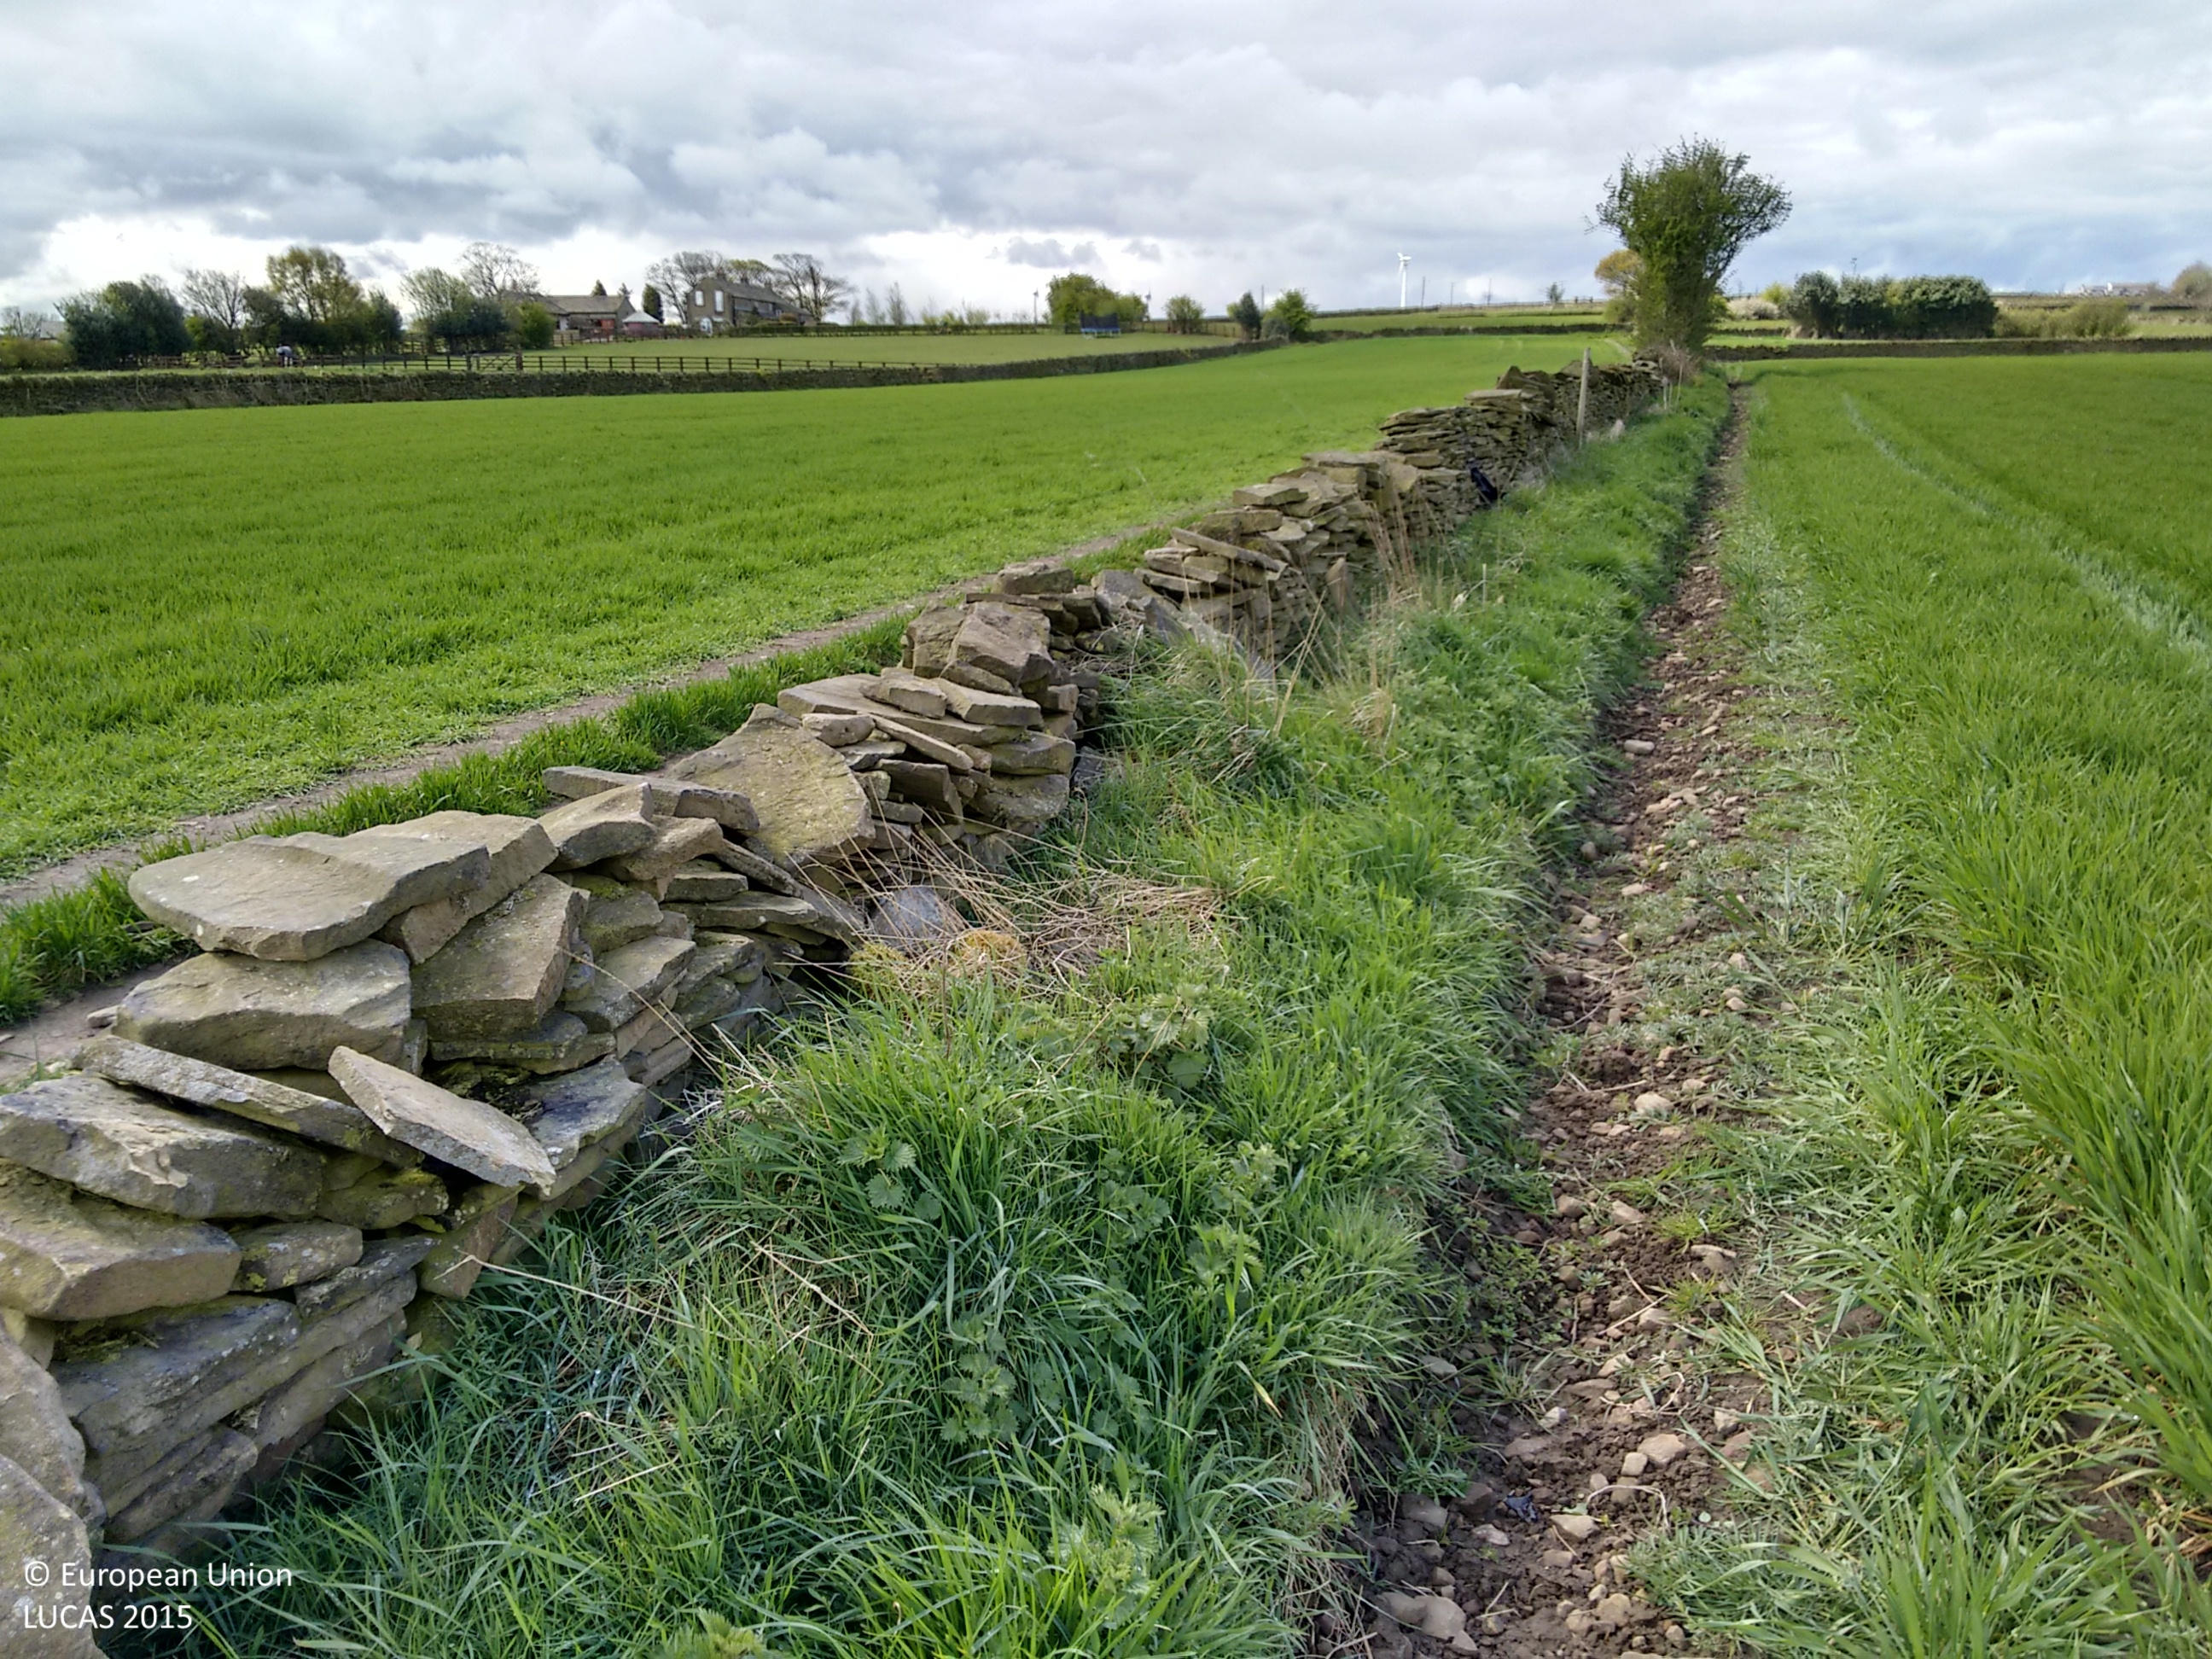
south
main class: Cropland
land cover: Barley
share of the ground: > 75 %
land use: Agriculture (excluding fallow land and kitchen gardens)
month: April
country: GB
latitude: 53.5631
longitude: -1.6626
